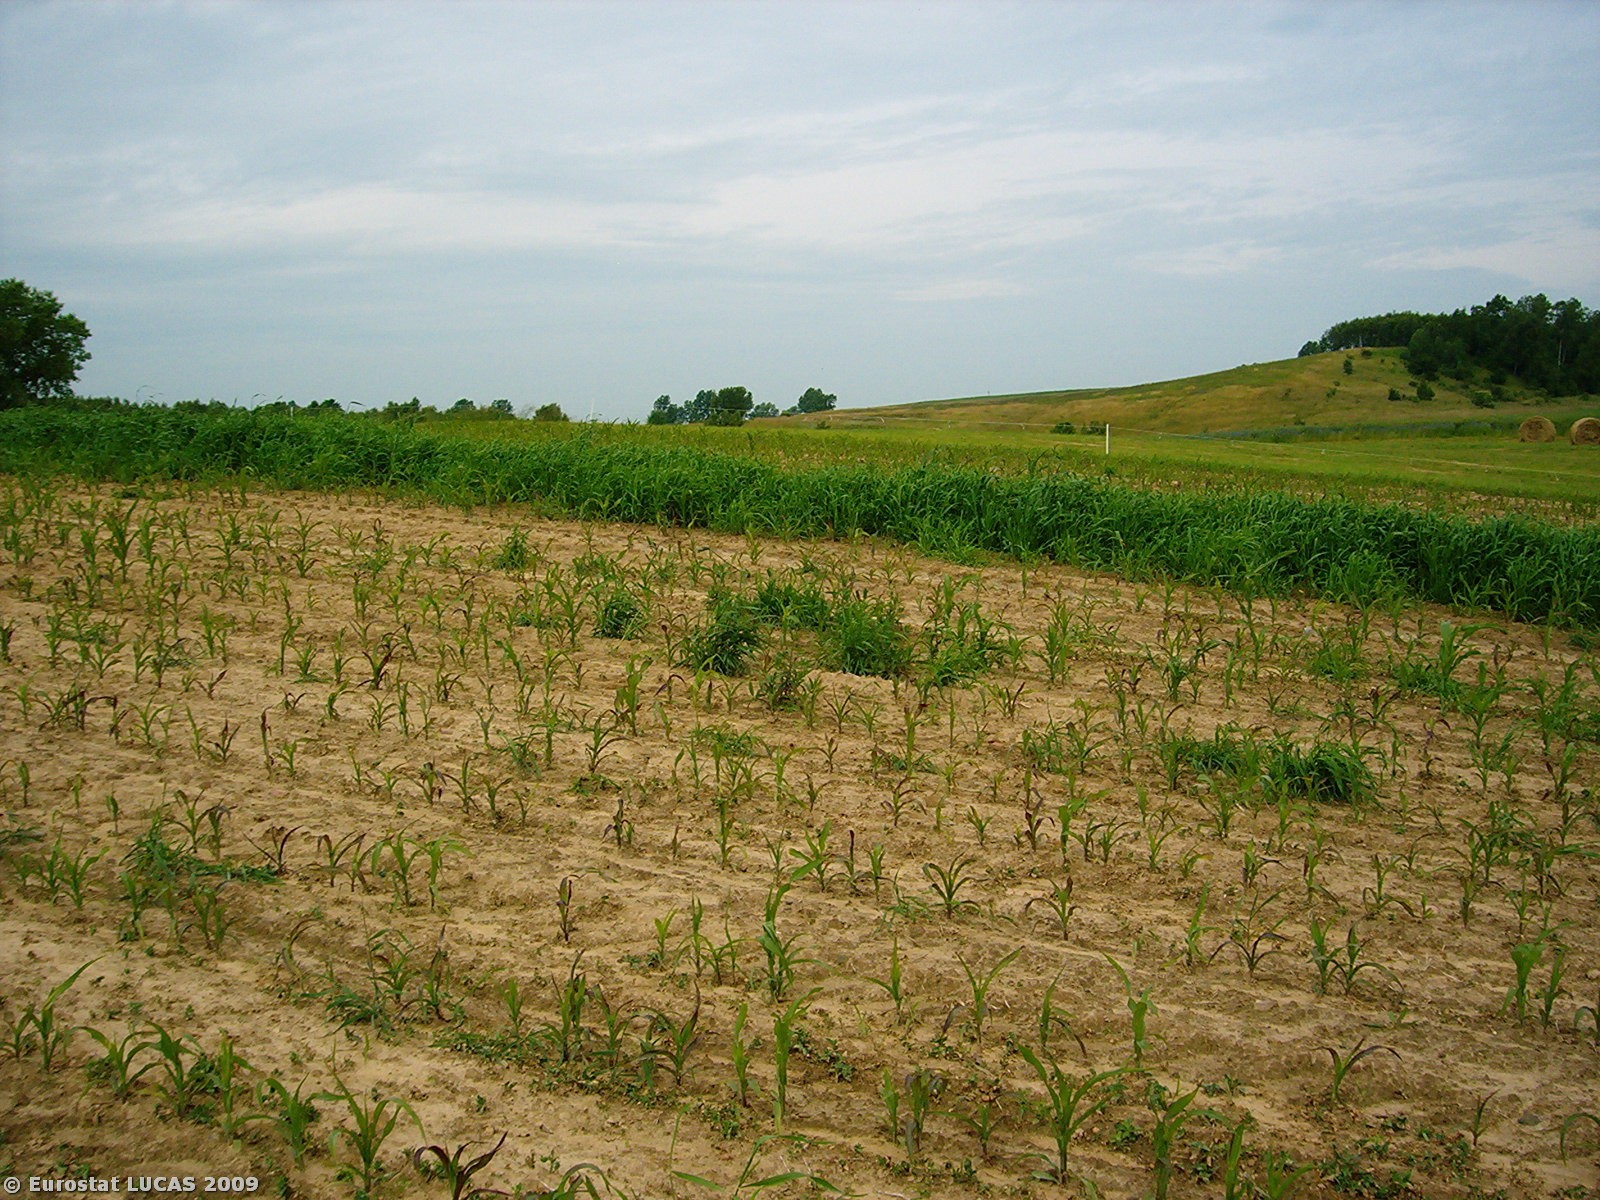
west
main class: Cropland
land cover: Maize
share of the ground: 10 - 25 %
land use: Agriculture (excluding fallow land and kitchen gardens)
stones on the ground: < 10 %
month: June
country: PL
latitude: 53.0989
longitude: 15.4547
